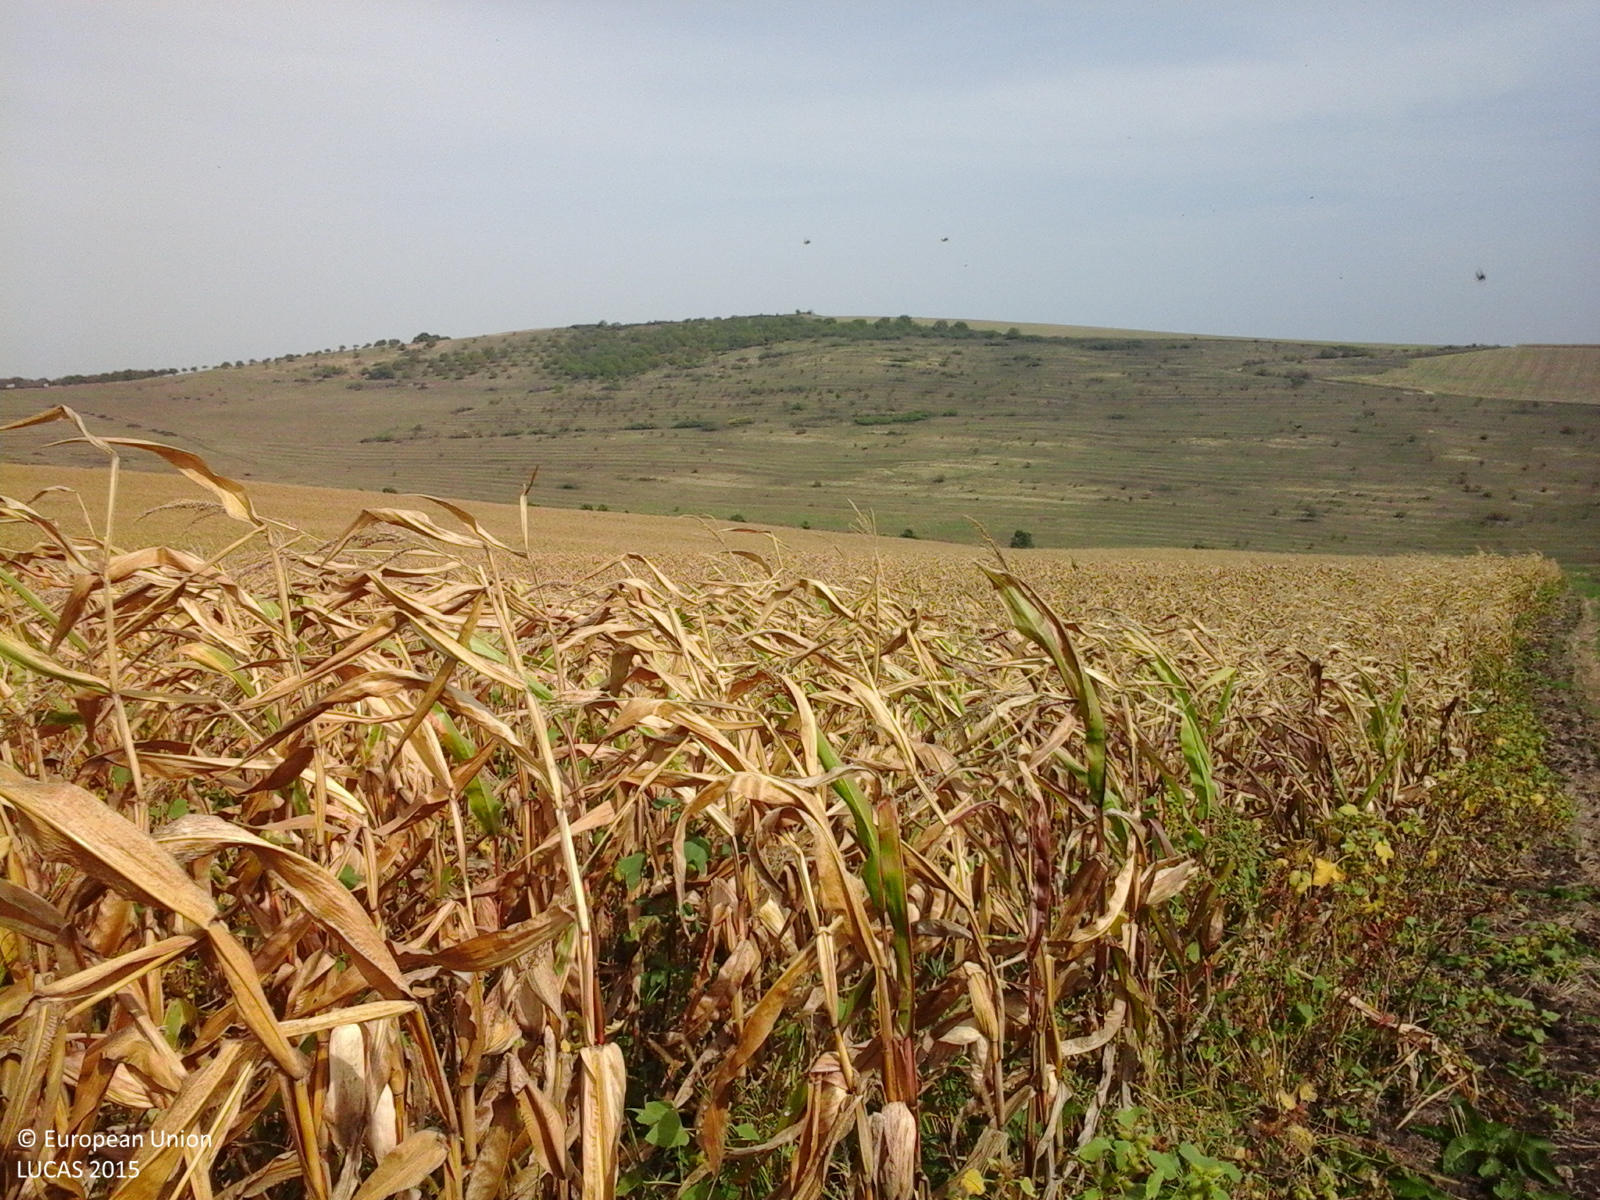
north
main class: Cropland
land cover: Maize
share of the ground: > 75 %
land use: Agriculture (excluding fallow land and kitchen gardens)
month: September
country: RO
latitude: 46.8135
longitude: 23.7166
